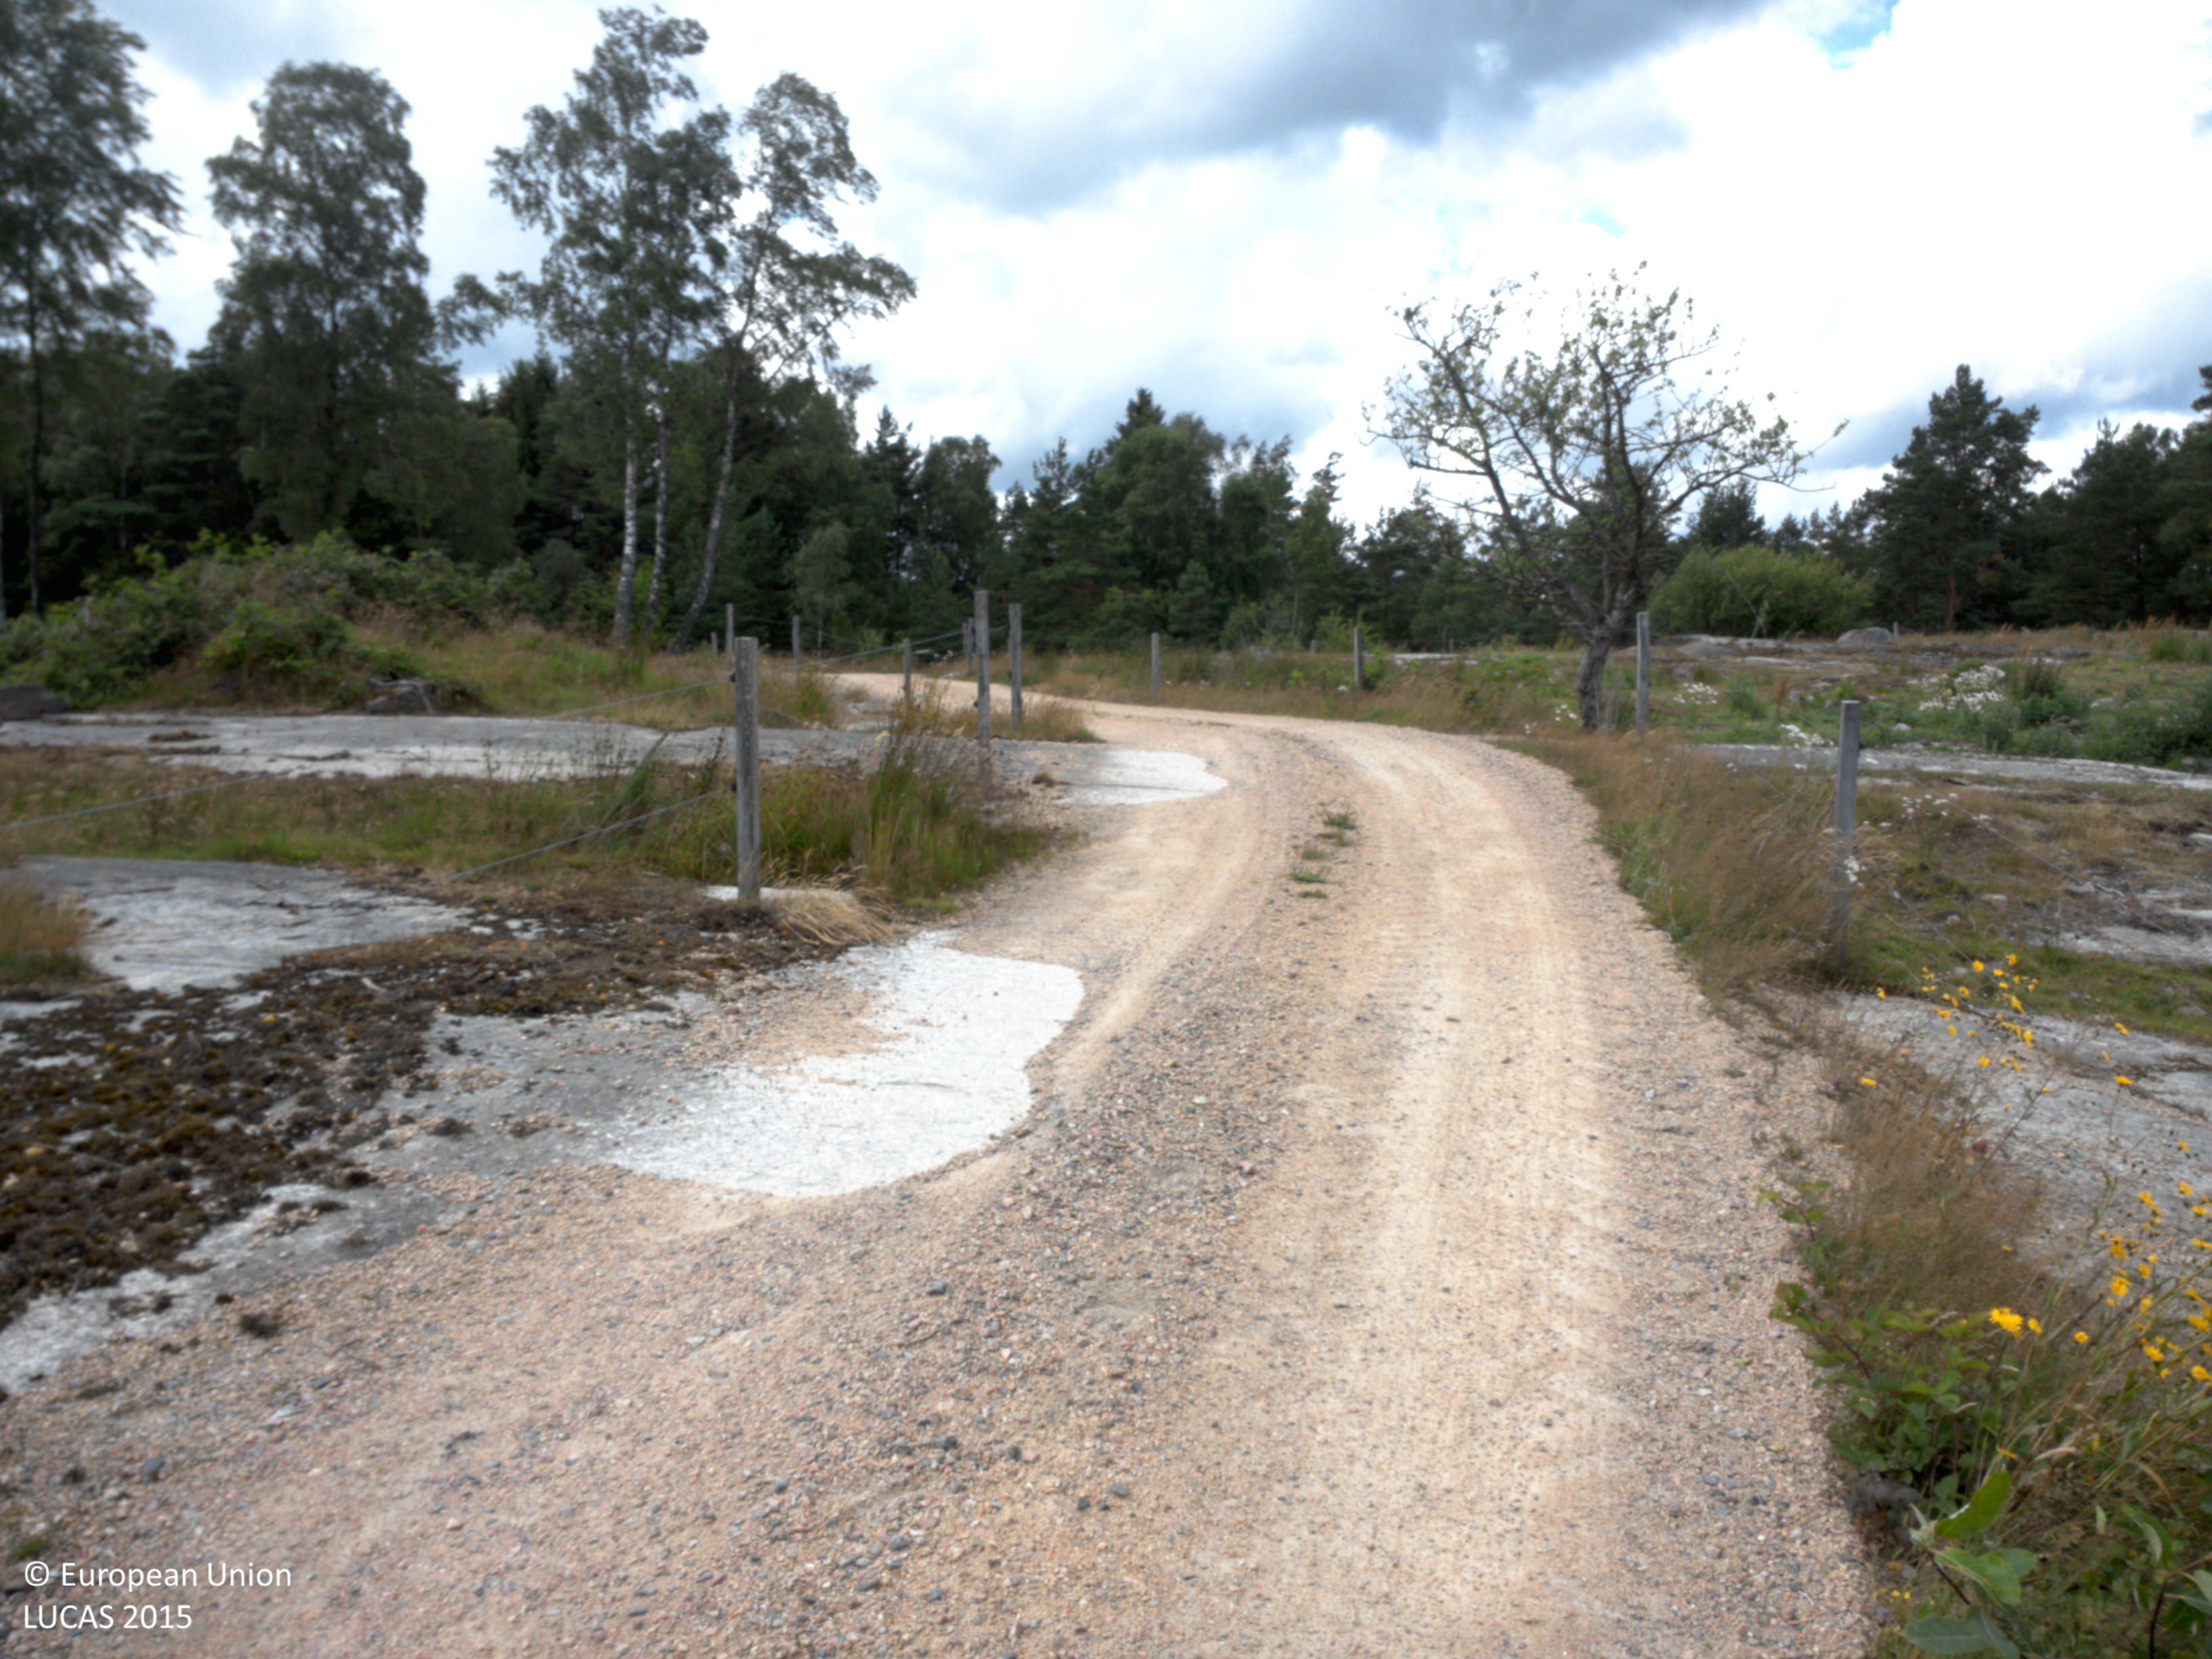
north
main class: Grassland
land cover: Grassland with sparse tree/shrub cover
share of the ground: > 75 %
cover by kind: herbaceous plants 75 %, consolidated bare surface 20 %, broadleaved forest trees 5 %
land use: Agriculture (excluding fallow land and kitchen gardens)
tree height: > 5 m
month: July
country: SE
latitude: 58.1897
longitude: 11.7825
